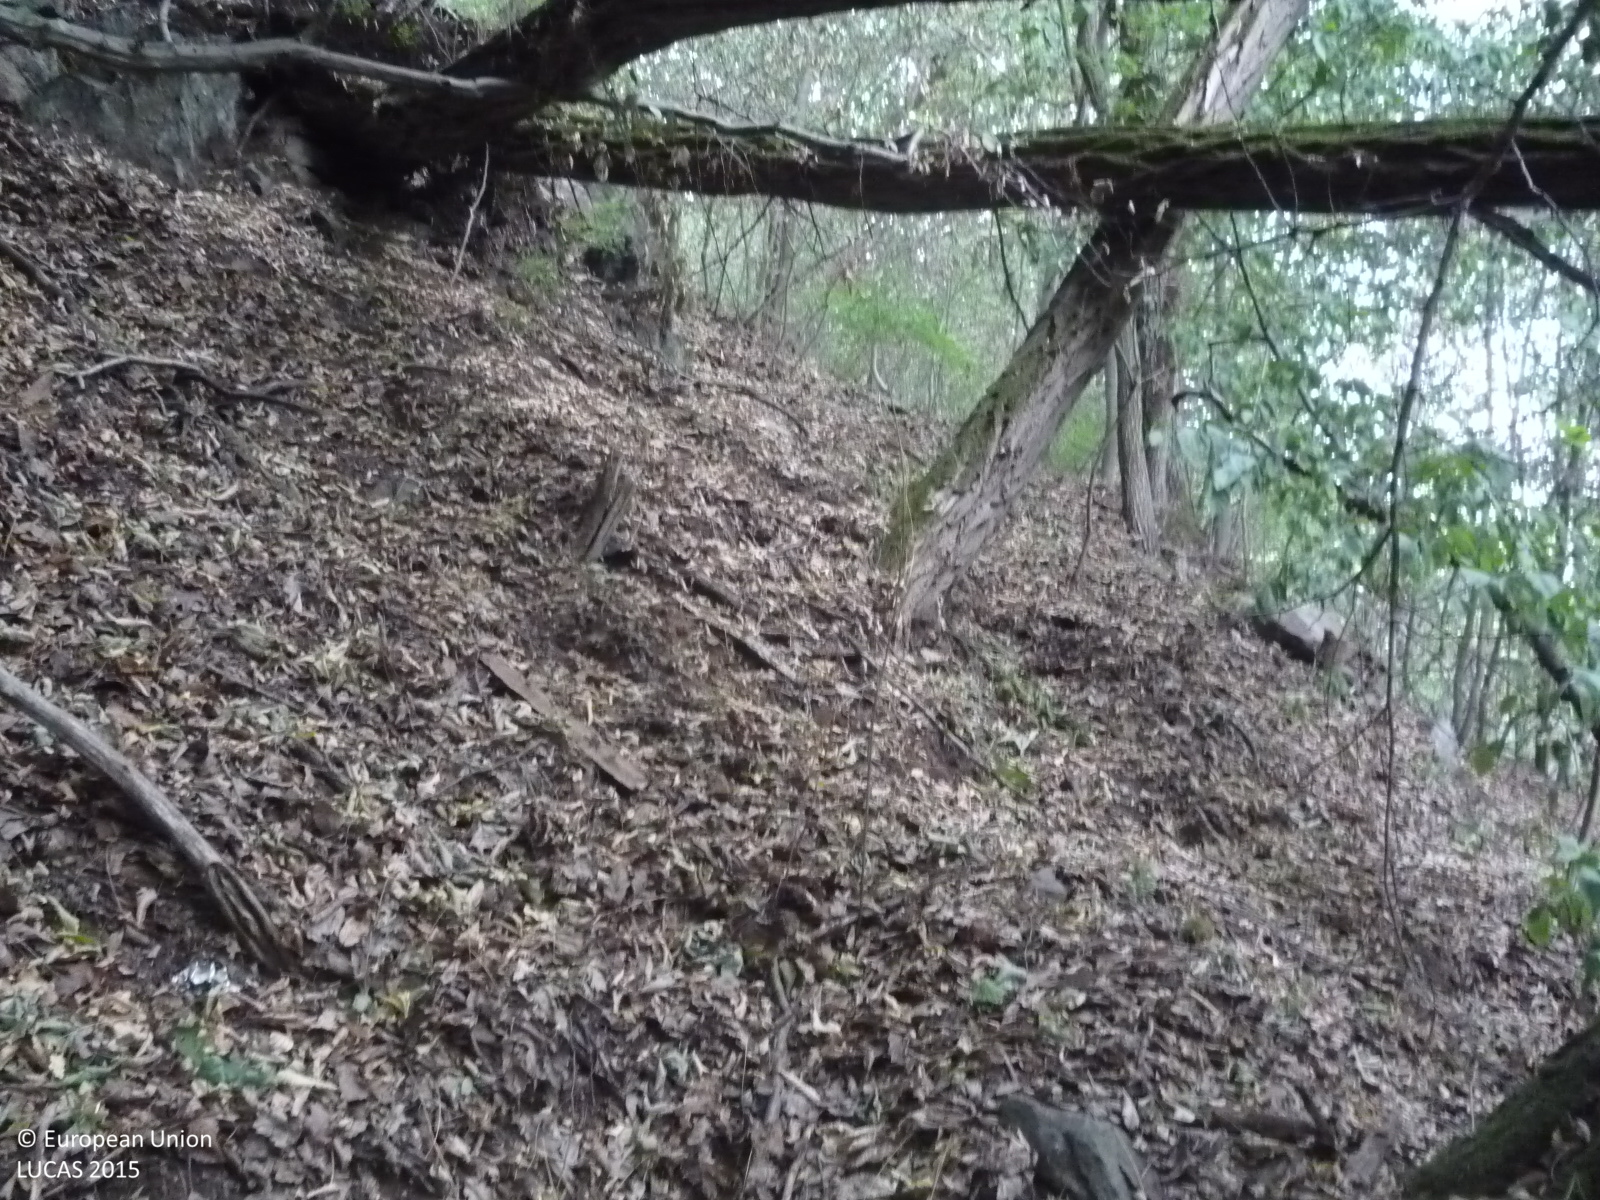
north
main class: Woodland
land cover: Broadleaved woodland
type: mesophytic deciduous forest
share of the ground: > 75 %
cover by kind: broadleaved forest trees 95 %, unconsolidated bare surface 5 %
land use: Forestry
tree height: > 5 m
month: August
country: CZ
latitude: 49.8626
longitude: 14.4671
